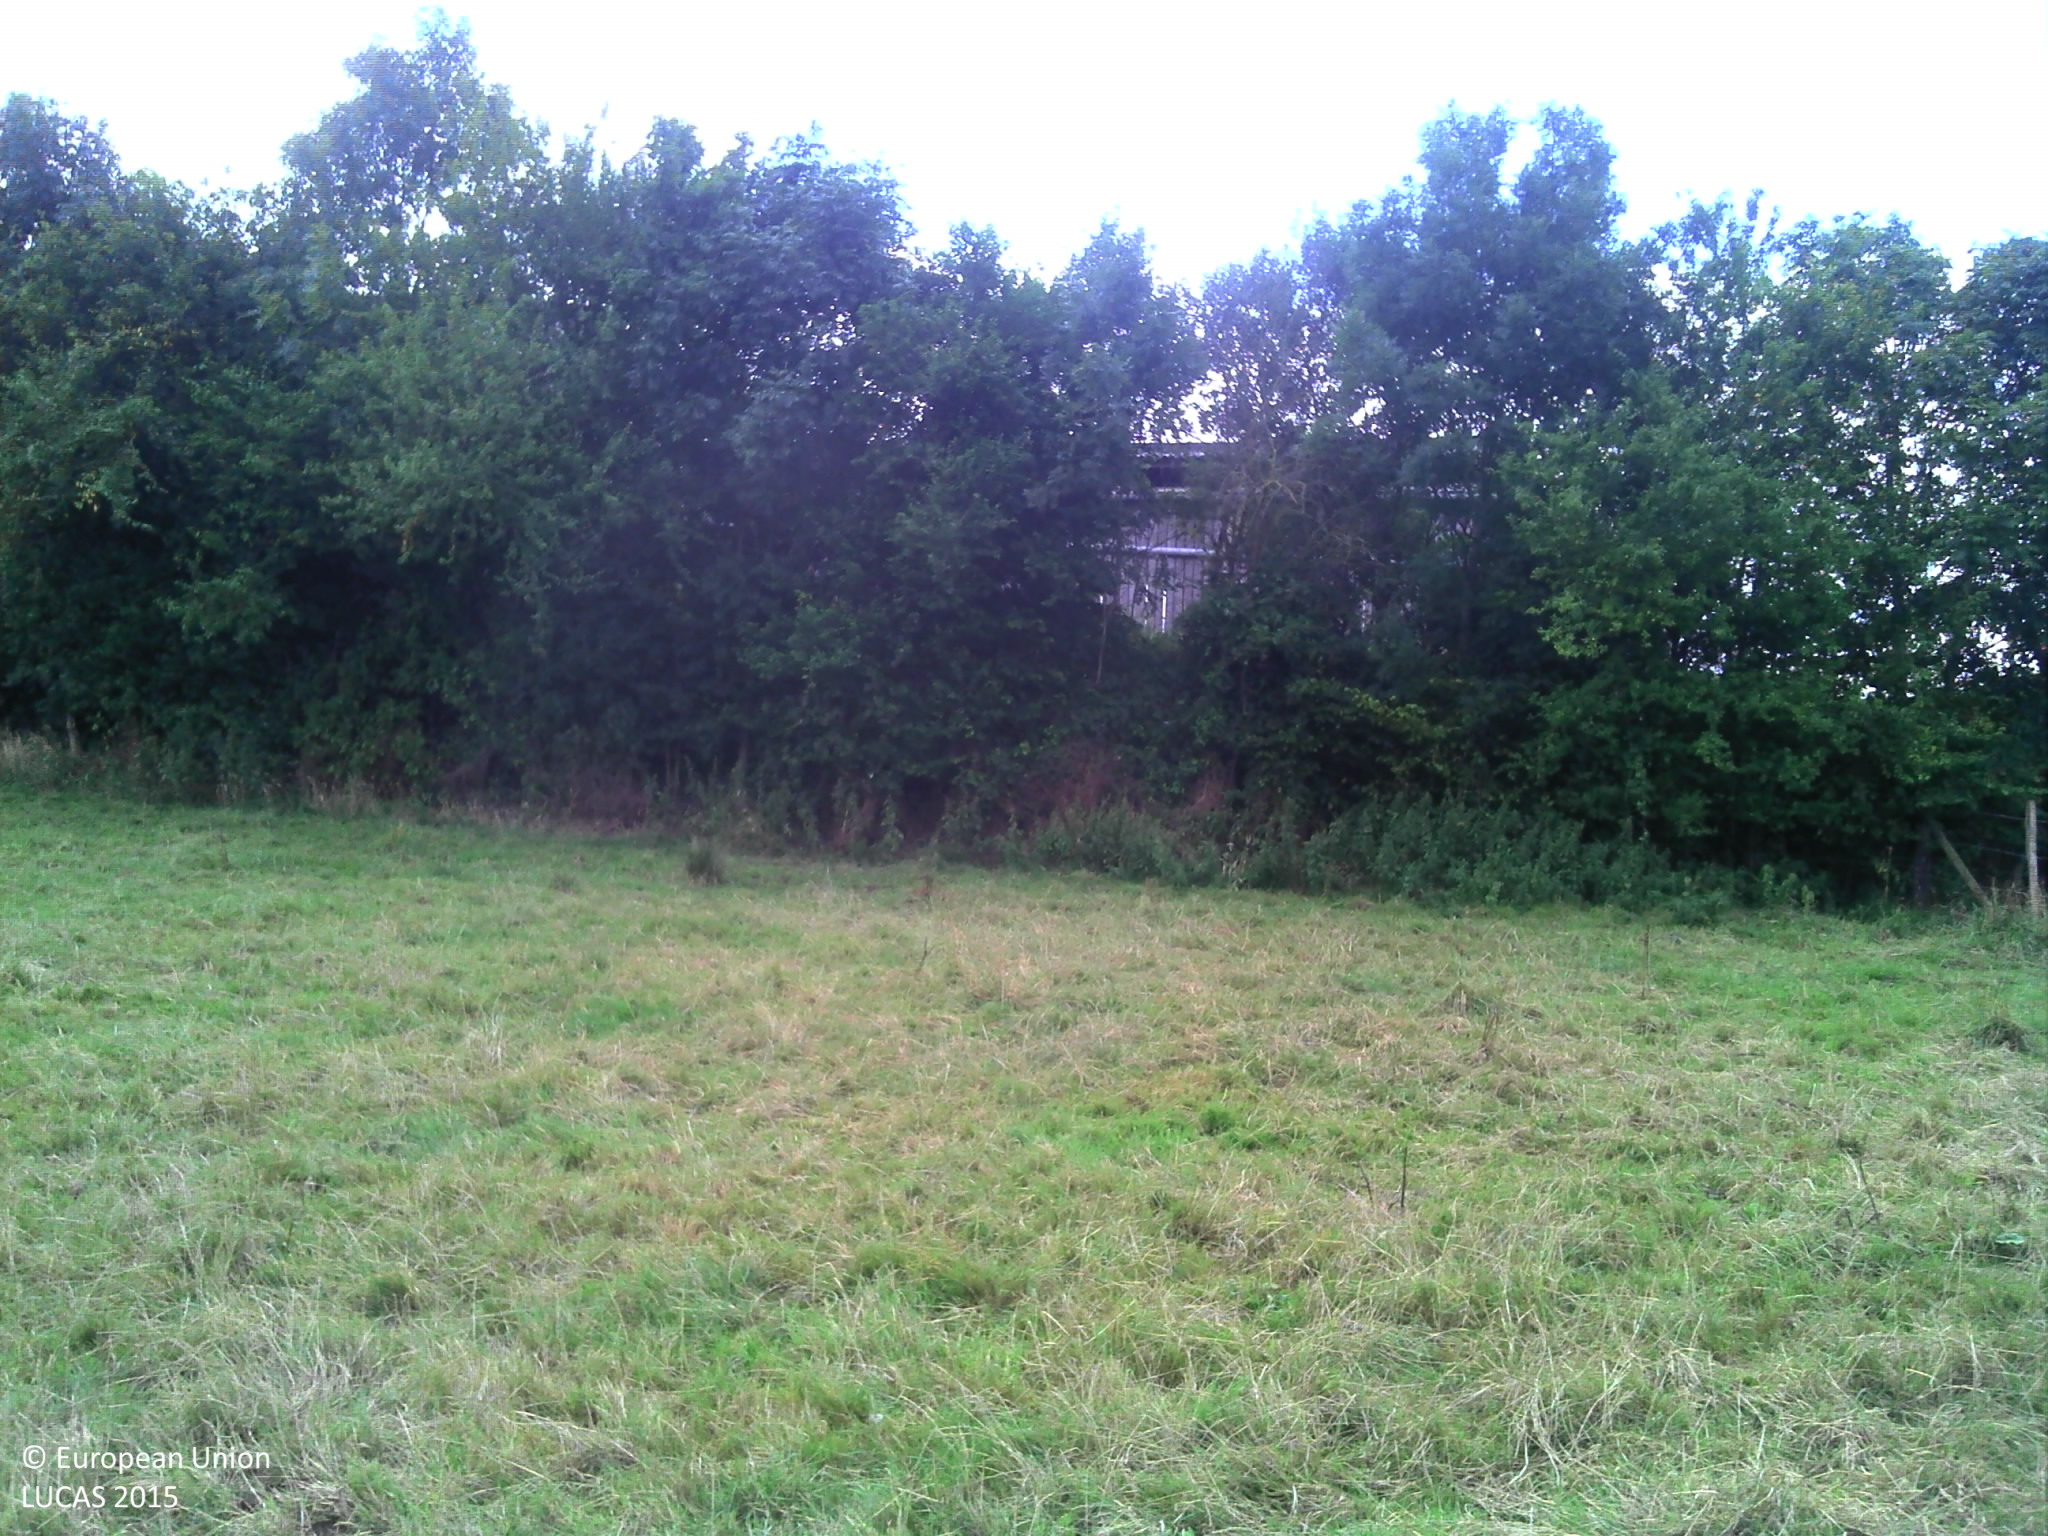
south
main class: Grassland
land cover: Grassland without tree/shrub cover
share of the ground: > 75 %
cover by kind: herbaceous plants 100 %
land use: Agriculture (excluding fallow land and kitchen gardens)
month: July
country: FR
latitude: 48.9143
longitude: 0.0498
